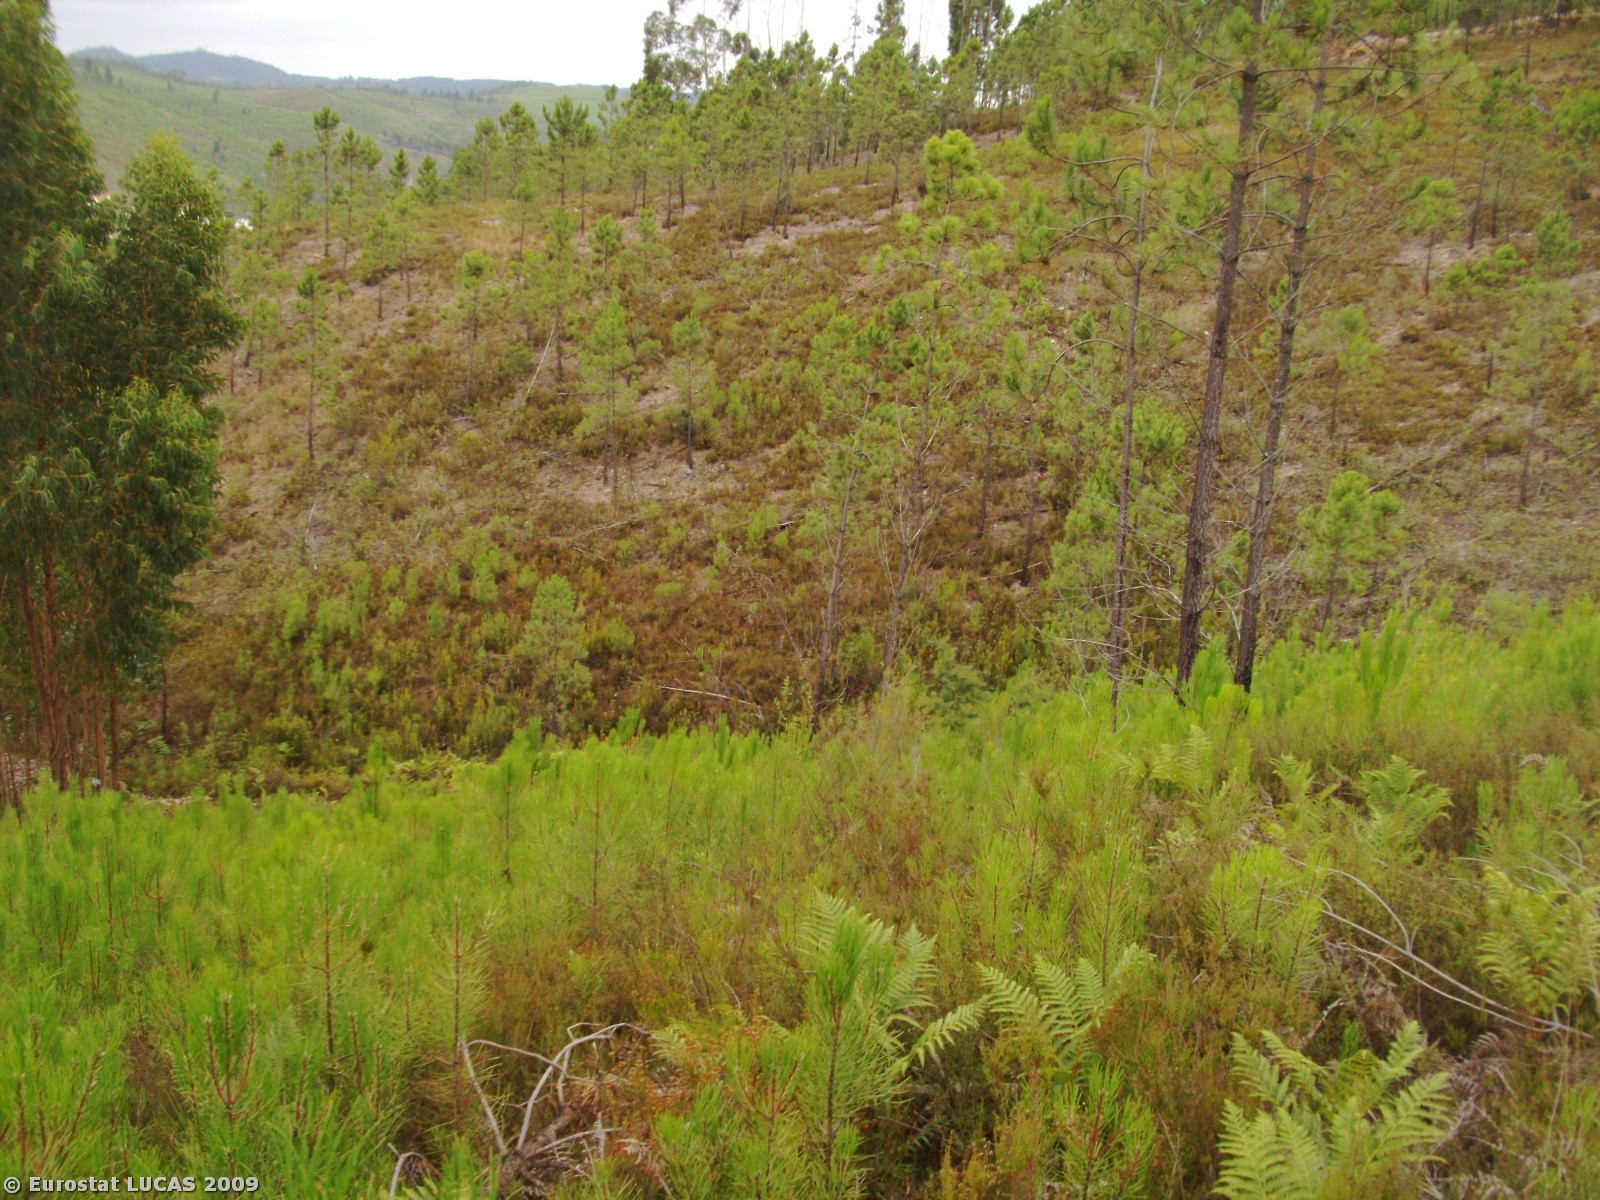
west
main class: Woodland
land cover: Coniferous woodland
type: coniferous forest of the mediterranean region
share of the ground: > 75 %
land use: Forestry
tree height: > 5 m
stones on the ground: > 50 %
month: July
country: PT
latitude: 39.6508
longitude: -8.1413
